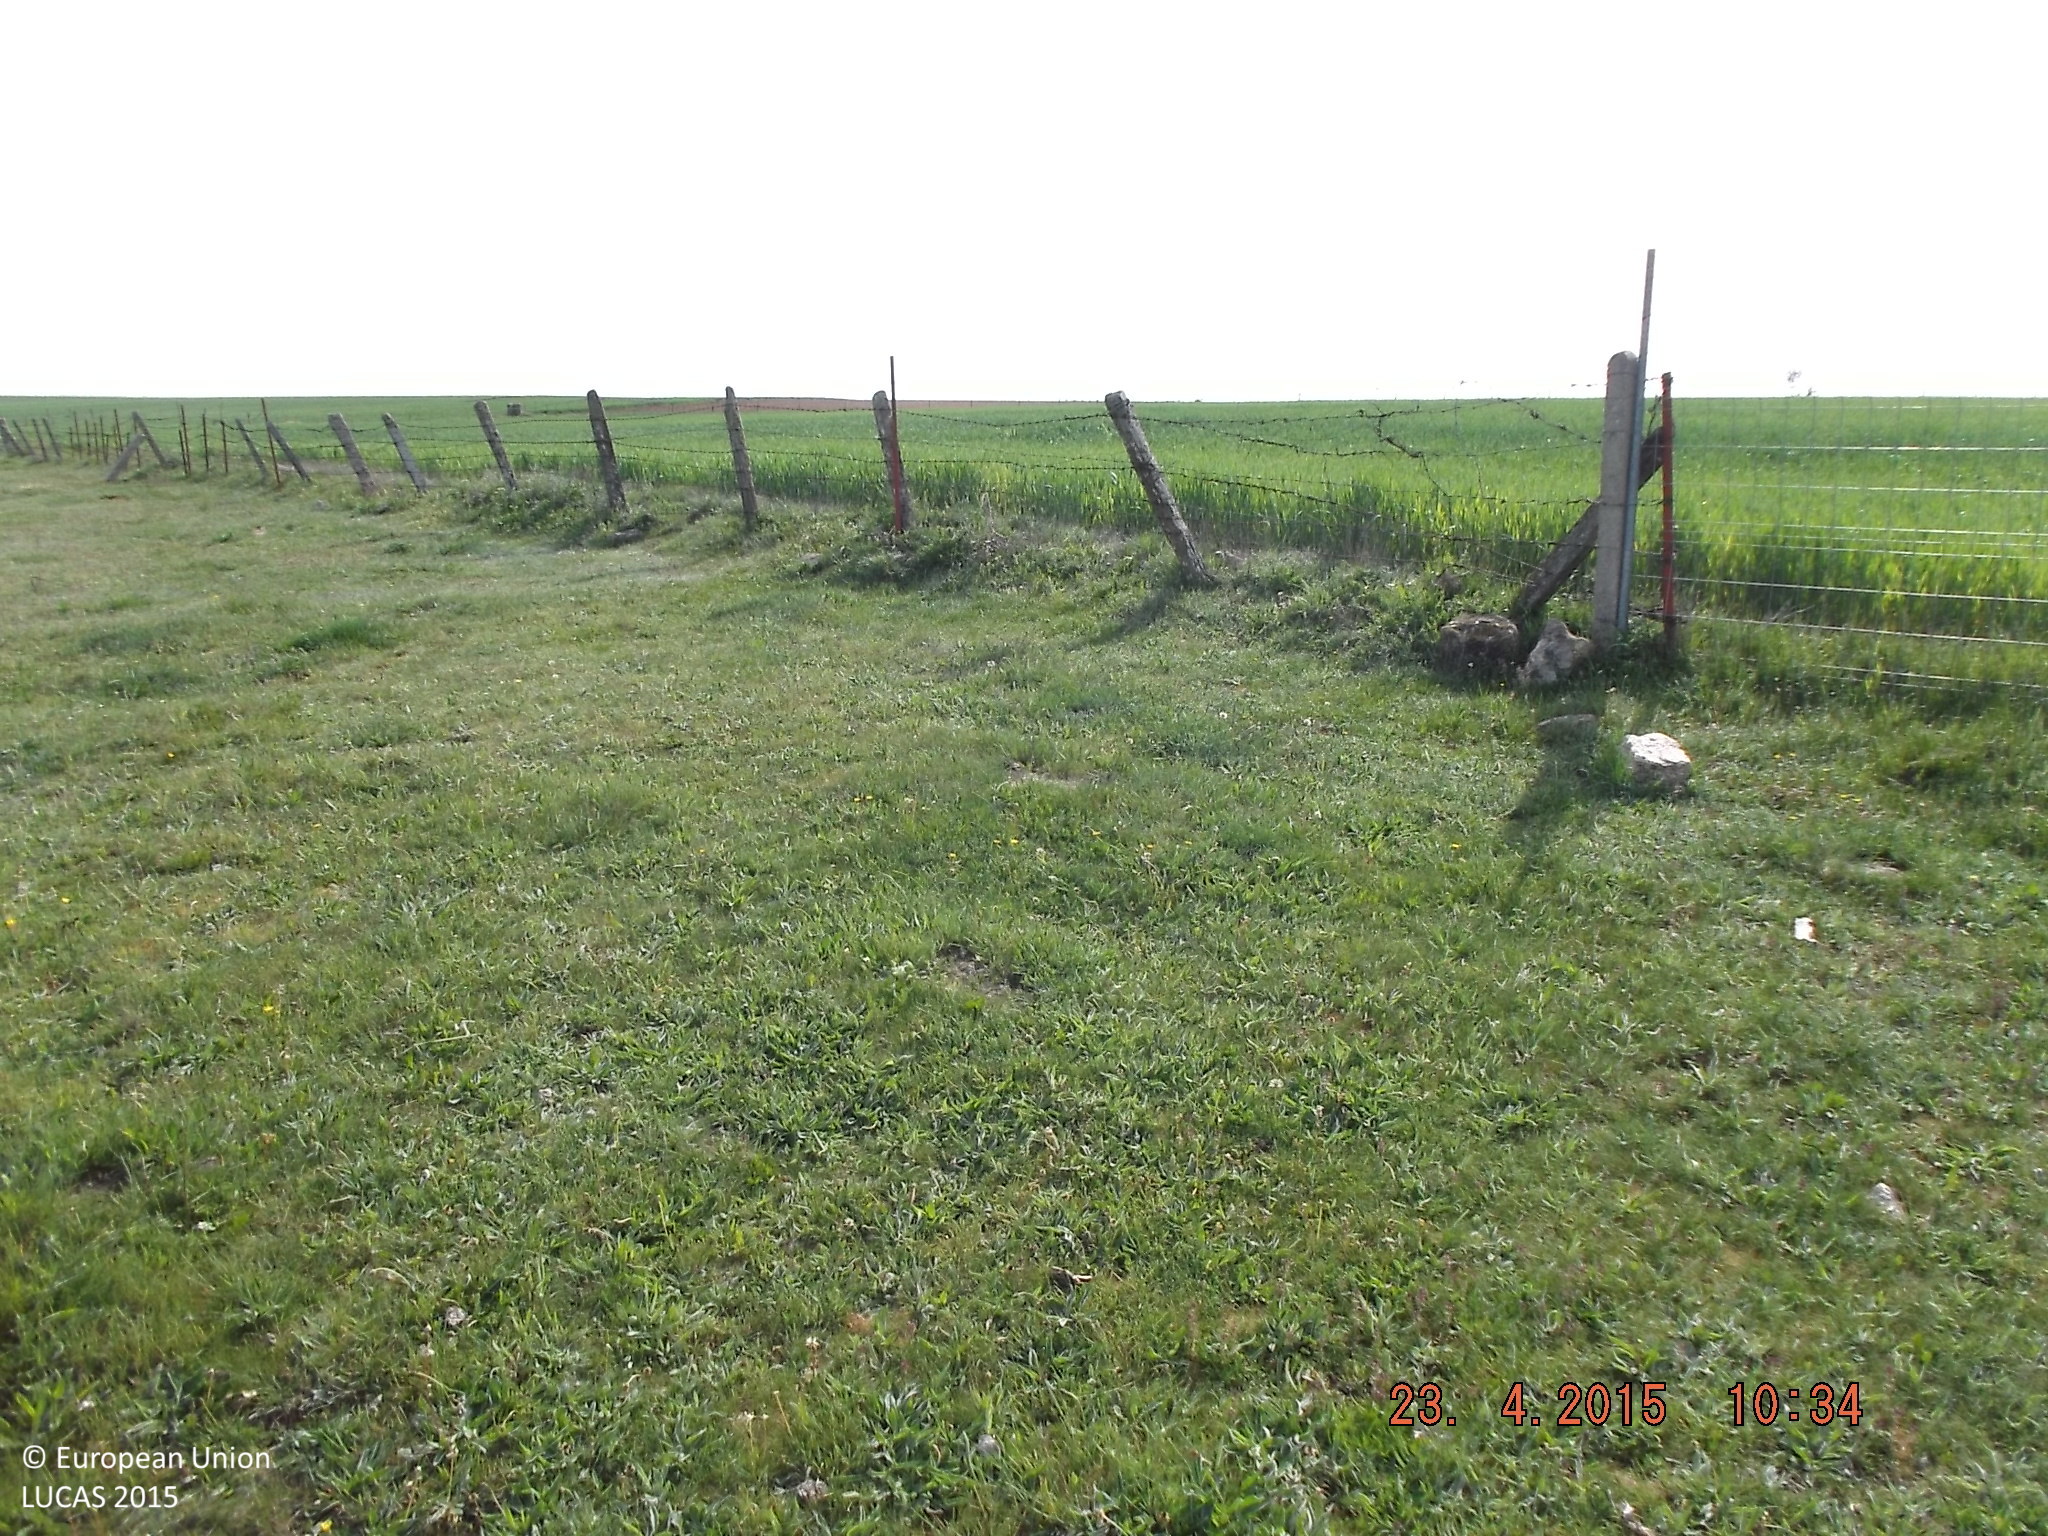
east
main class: Grassland
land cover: Grassland without tree/shrub cover
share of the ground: > 75 %
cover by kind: herbaceous plants 100 %
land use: Agriculture (excluding fallow land and kitchen gardens)
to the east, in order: Grassland without tree/shrub cover; Fences; Grass margins; Oats; Grass margins; Fences; Grass margins; Other bare soil
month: April
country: ES
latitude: 40.9450
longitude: -5.9162
